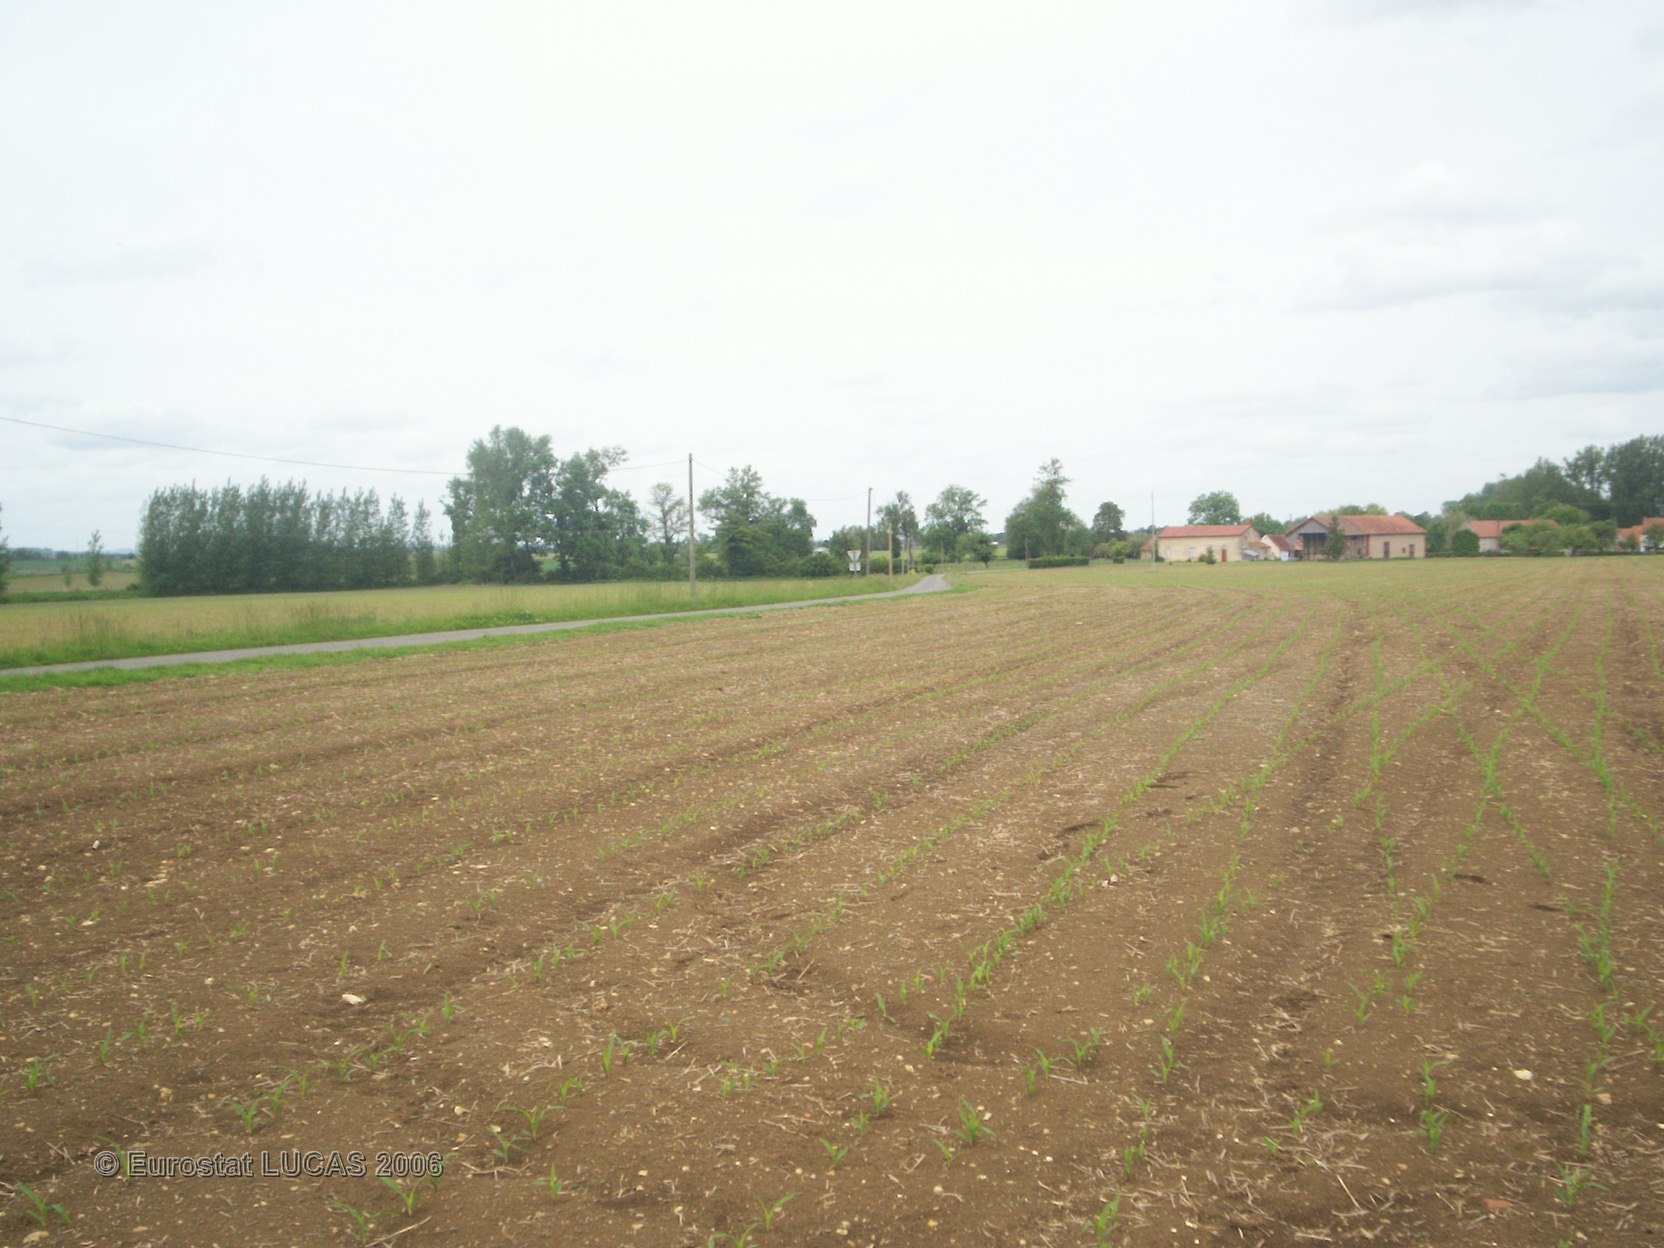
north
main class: Cropland
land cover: Maize
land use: Agriculture (excluding fallow land and kitchen gardens)
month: May
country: FR
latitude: 46.0828
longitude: 3.2359
